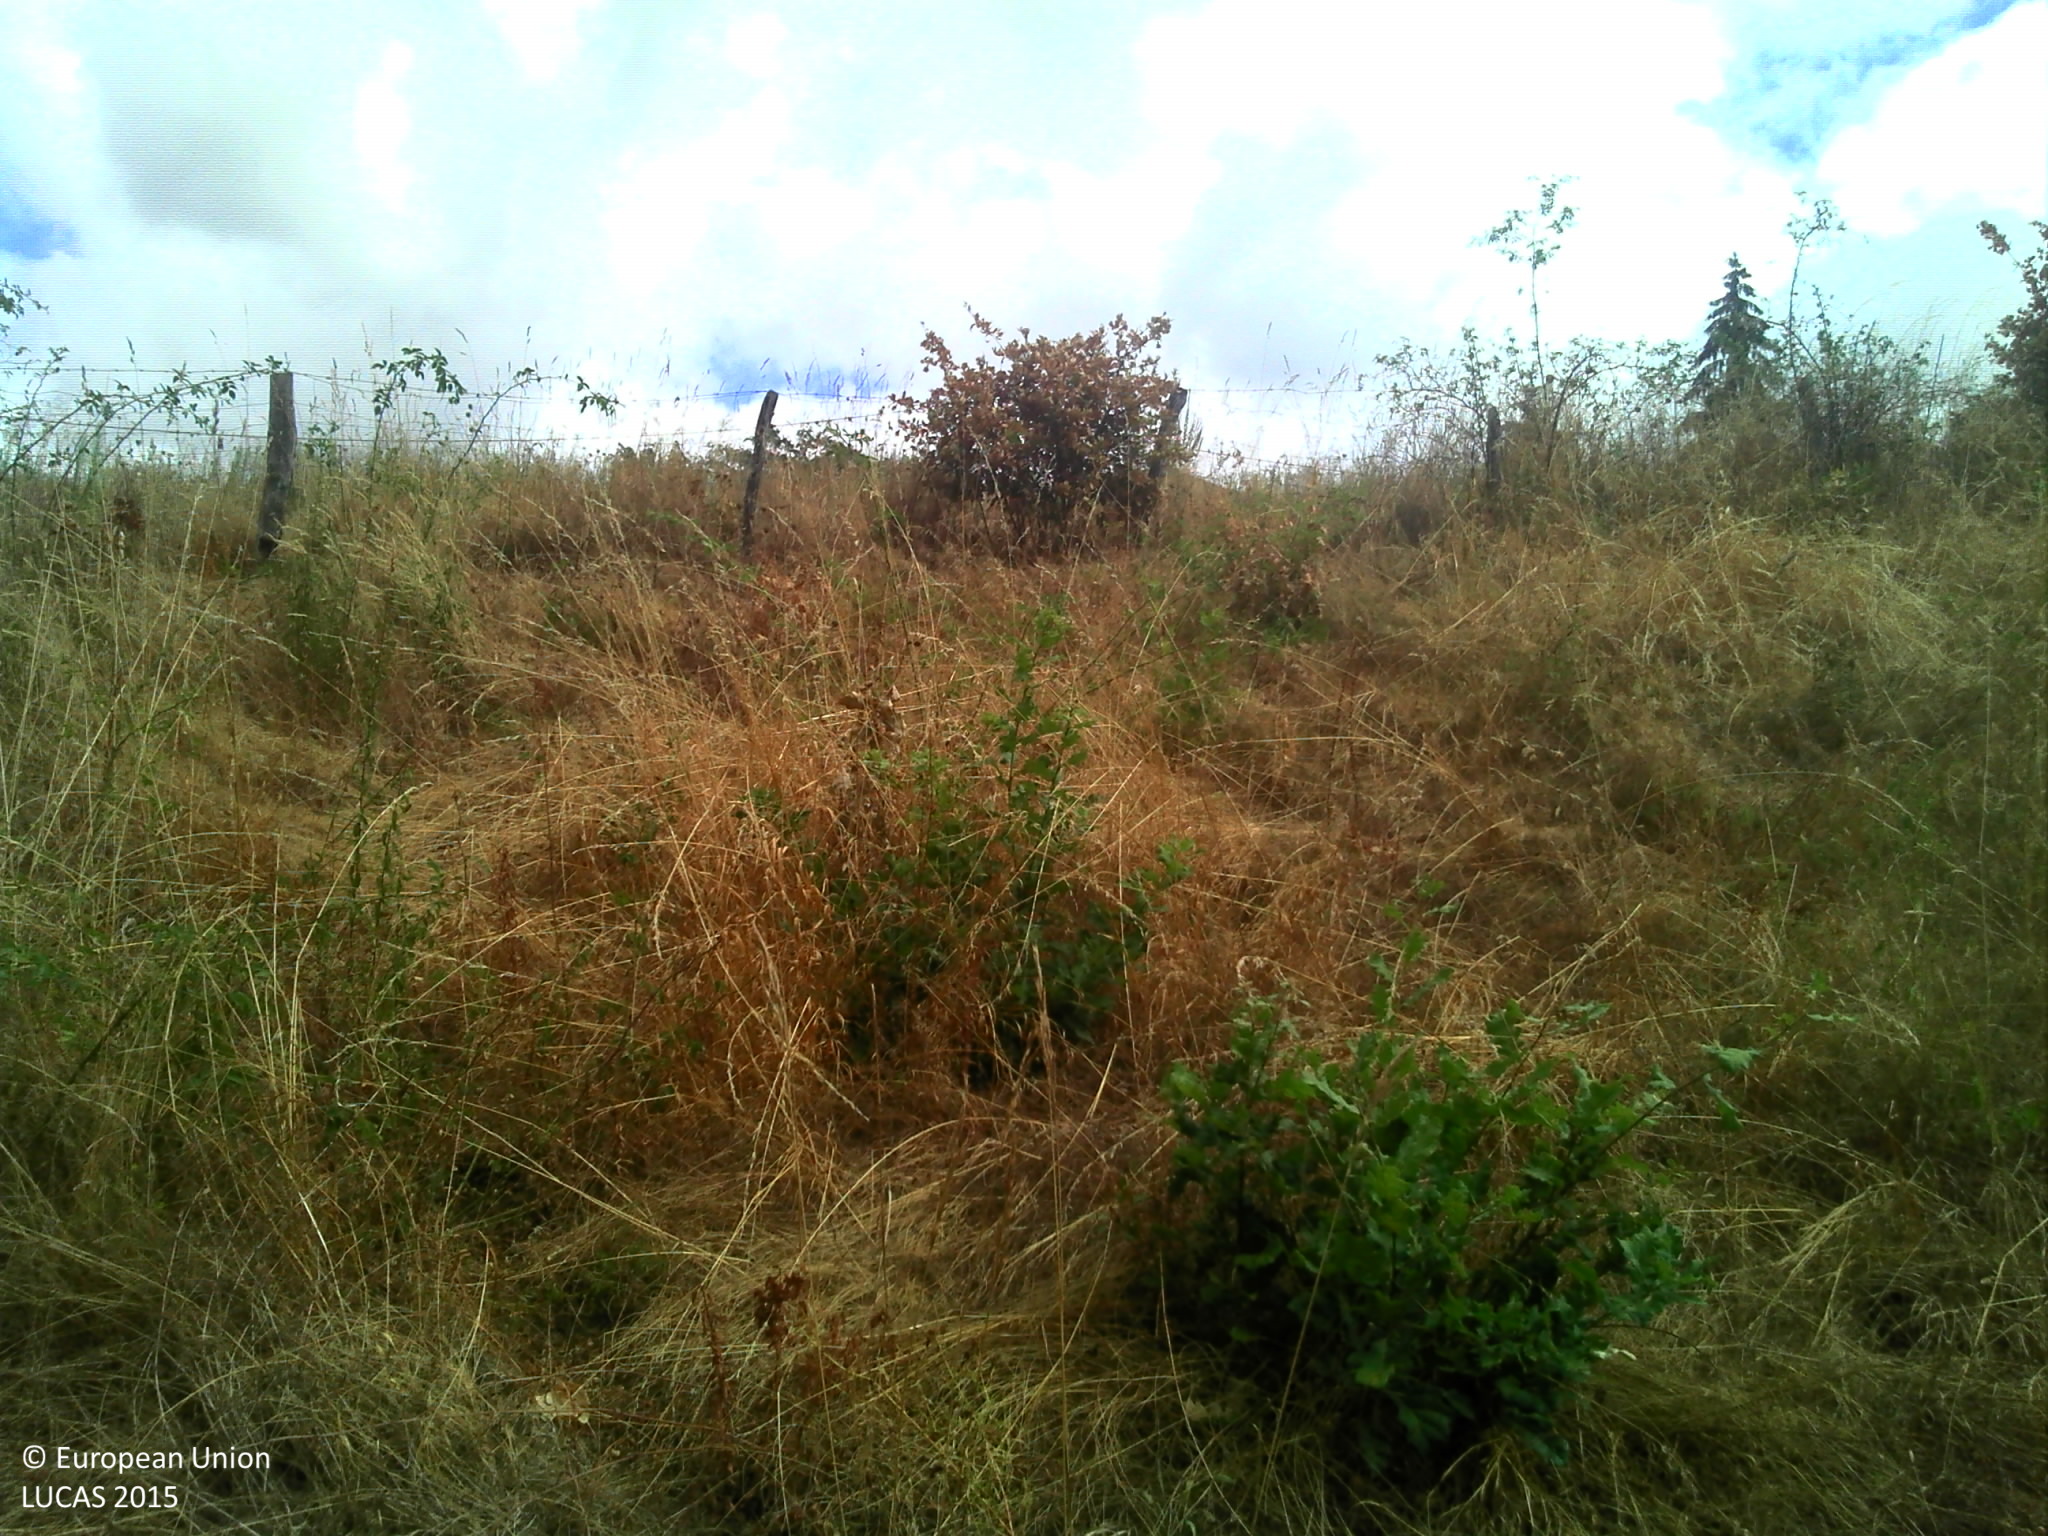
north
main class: Grassland
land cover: Spontaneously vegetated surfaces
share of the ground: > 75 %
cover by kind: herbaceous plants 80 %, lichens and mosses 15 %, shrubs 5 %
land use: Semi-natural and natural areas not in use
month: July
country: FR
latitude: 45.7796
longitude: 4.5628
